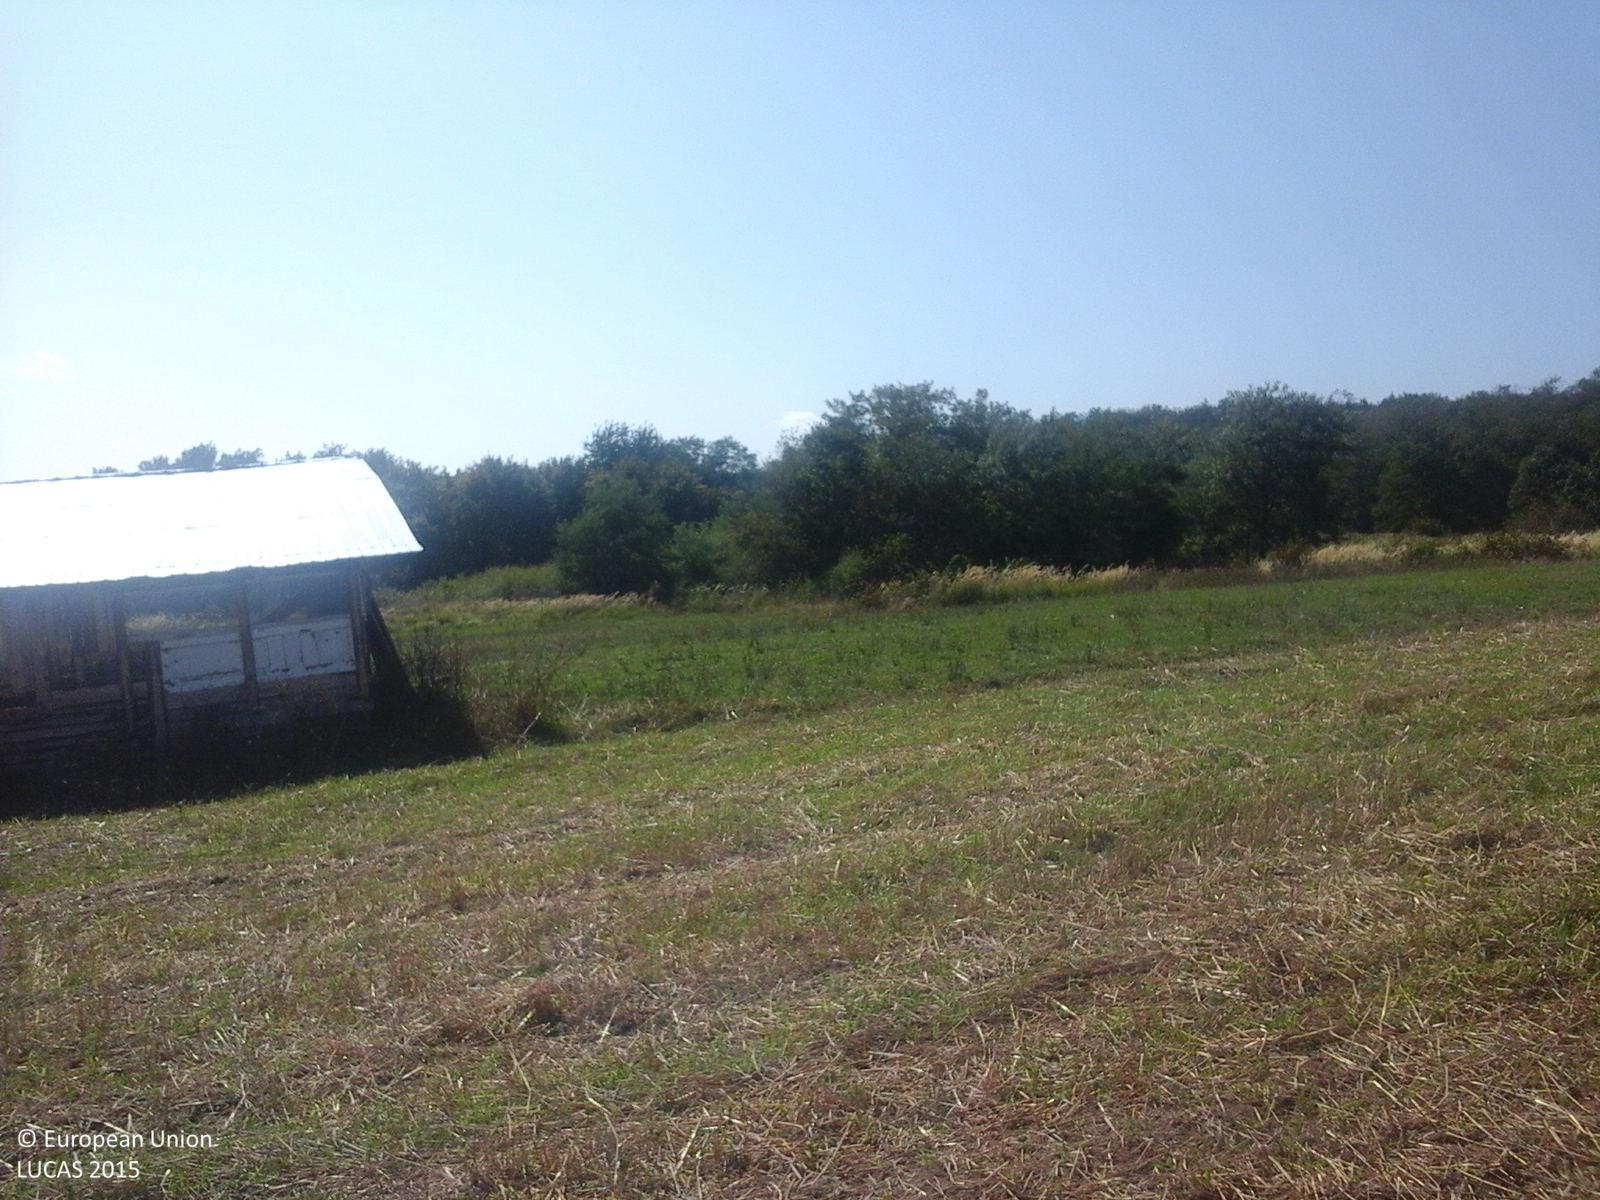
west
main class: Cropland
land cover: Common wheat
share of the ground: < 10 %
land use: Agriculture (excluding fallow land and kitchen gardens)
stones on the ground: < 10 %
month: September
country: RO
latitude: 47.1621
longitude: 22.8158
